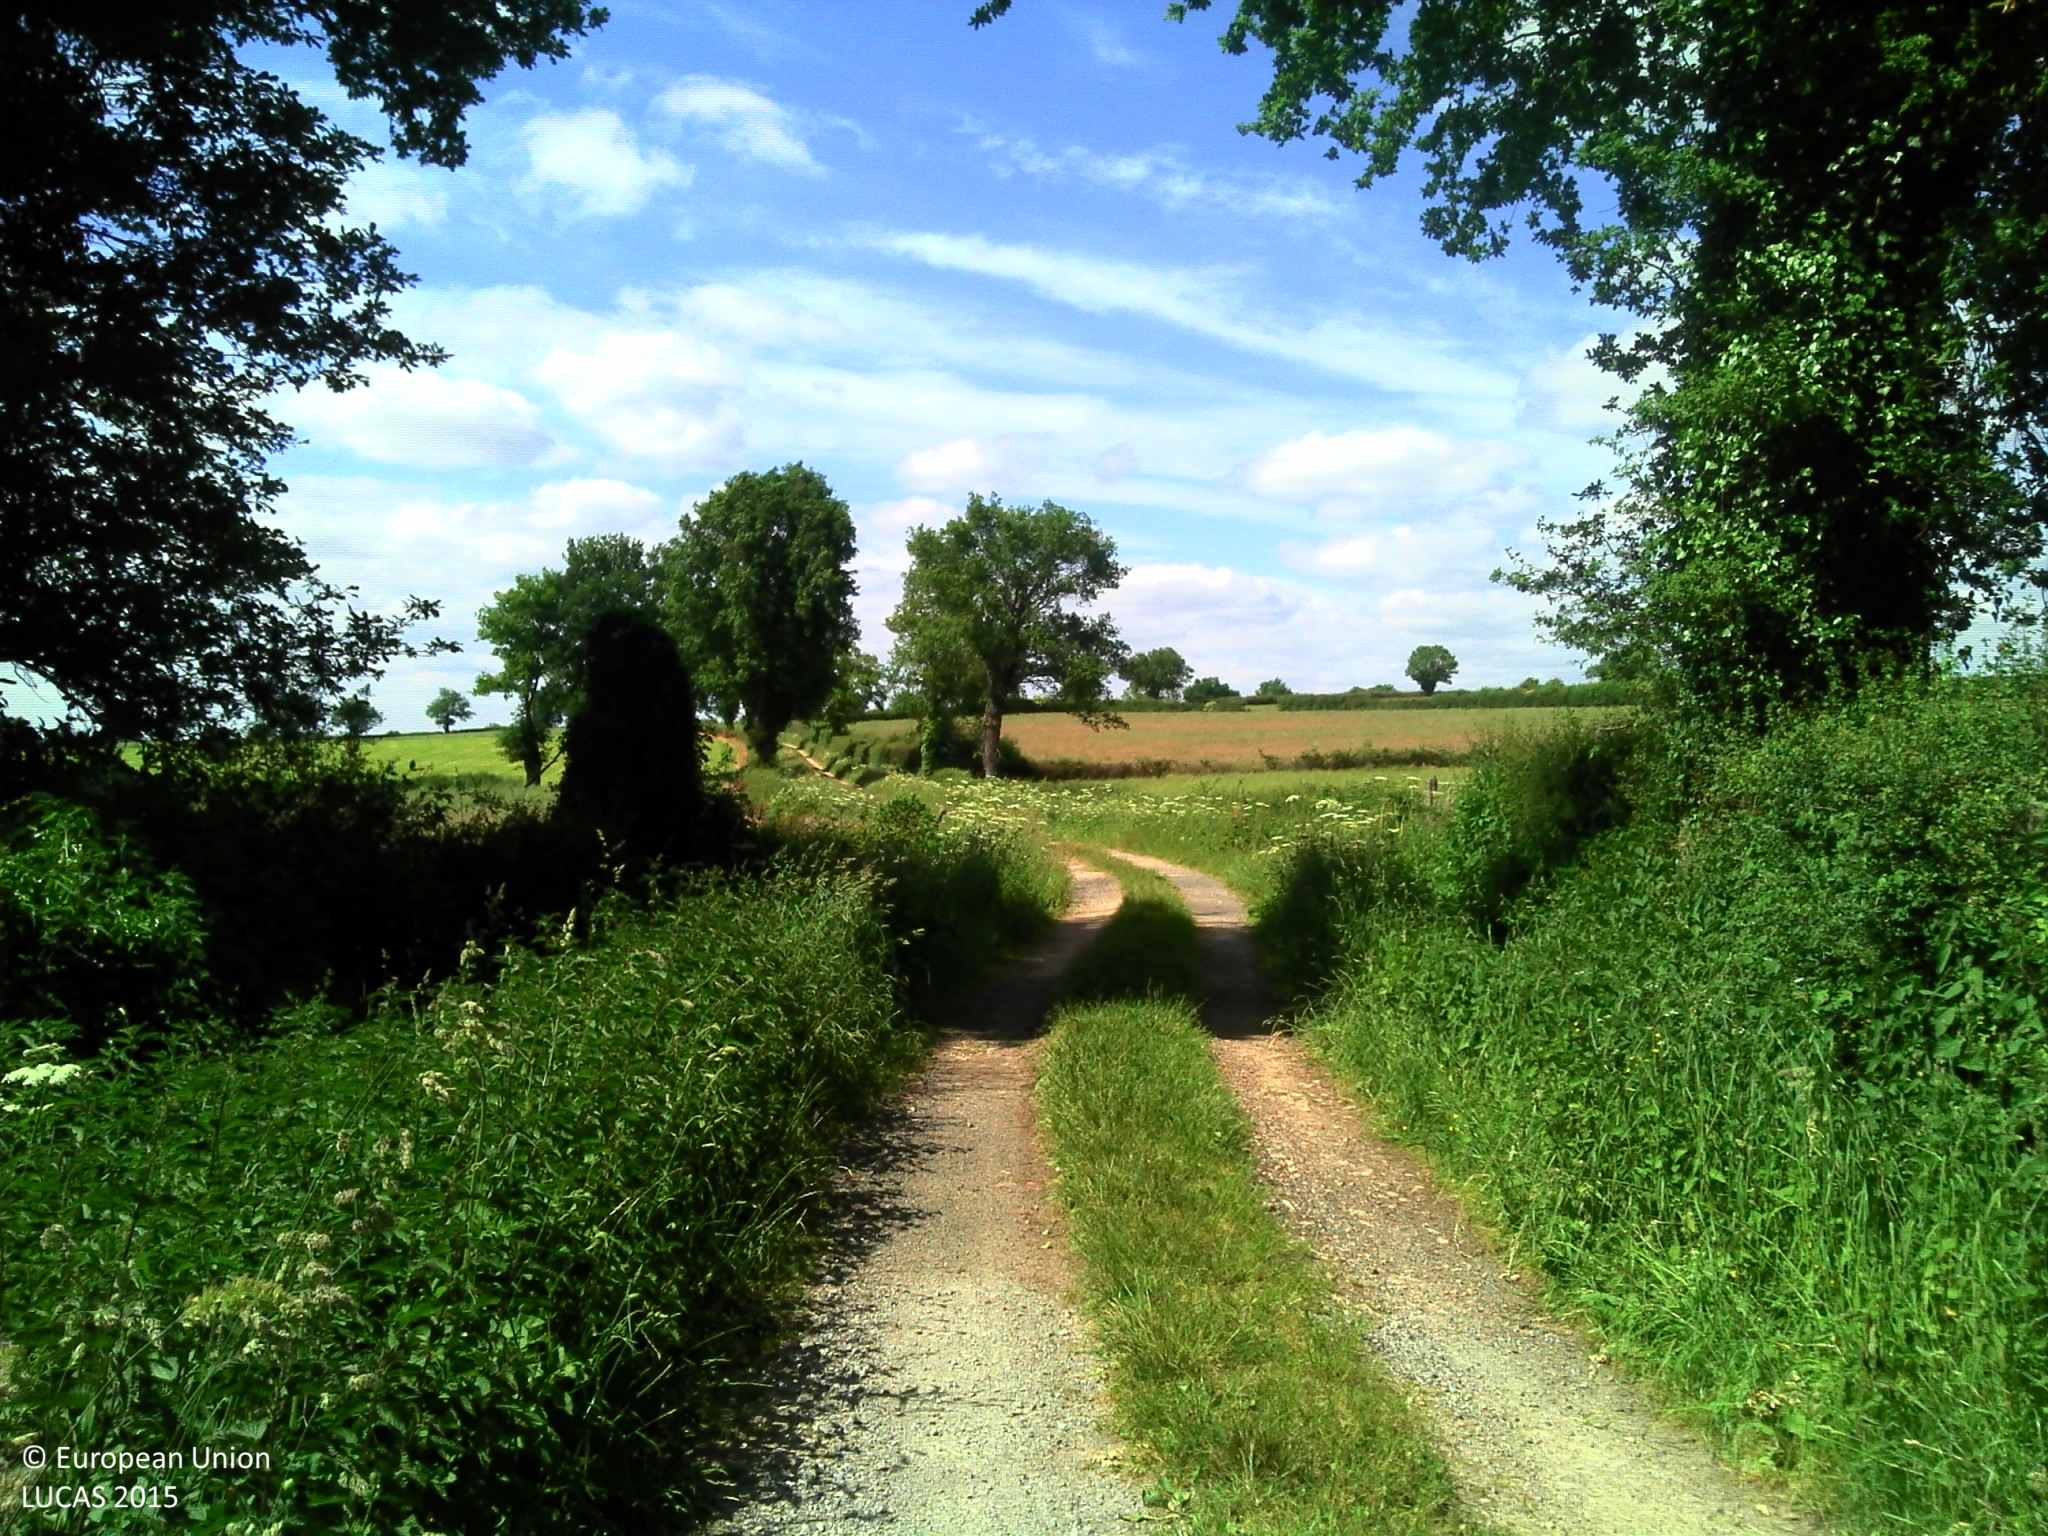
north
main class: Woodland
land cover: Spruce dominated mixed woodland
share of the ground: > 75 %
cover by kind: broadleaved forest trees 75 %, coniferous forest trees 25 %
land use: Residential
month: May
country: FR
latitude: 46.3211
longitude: 2.7365
